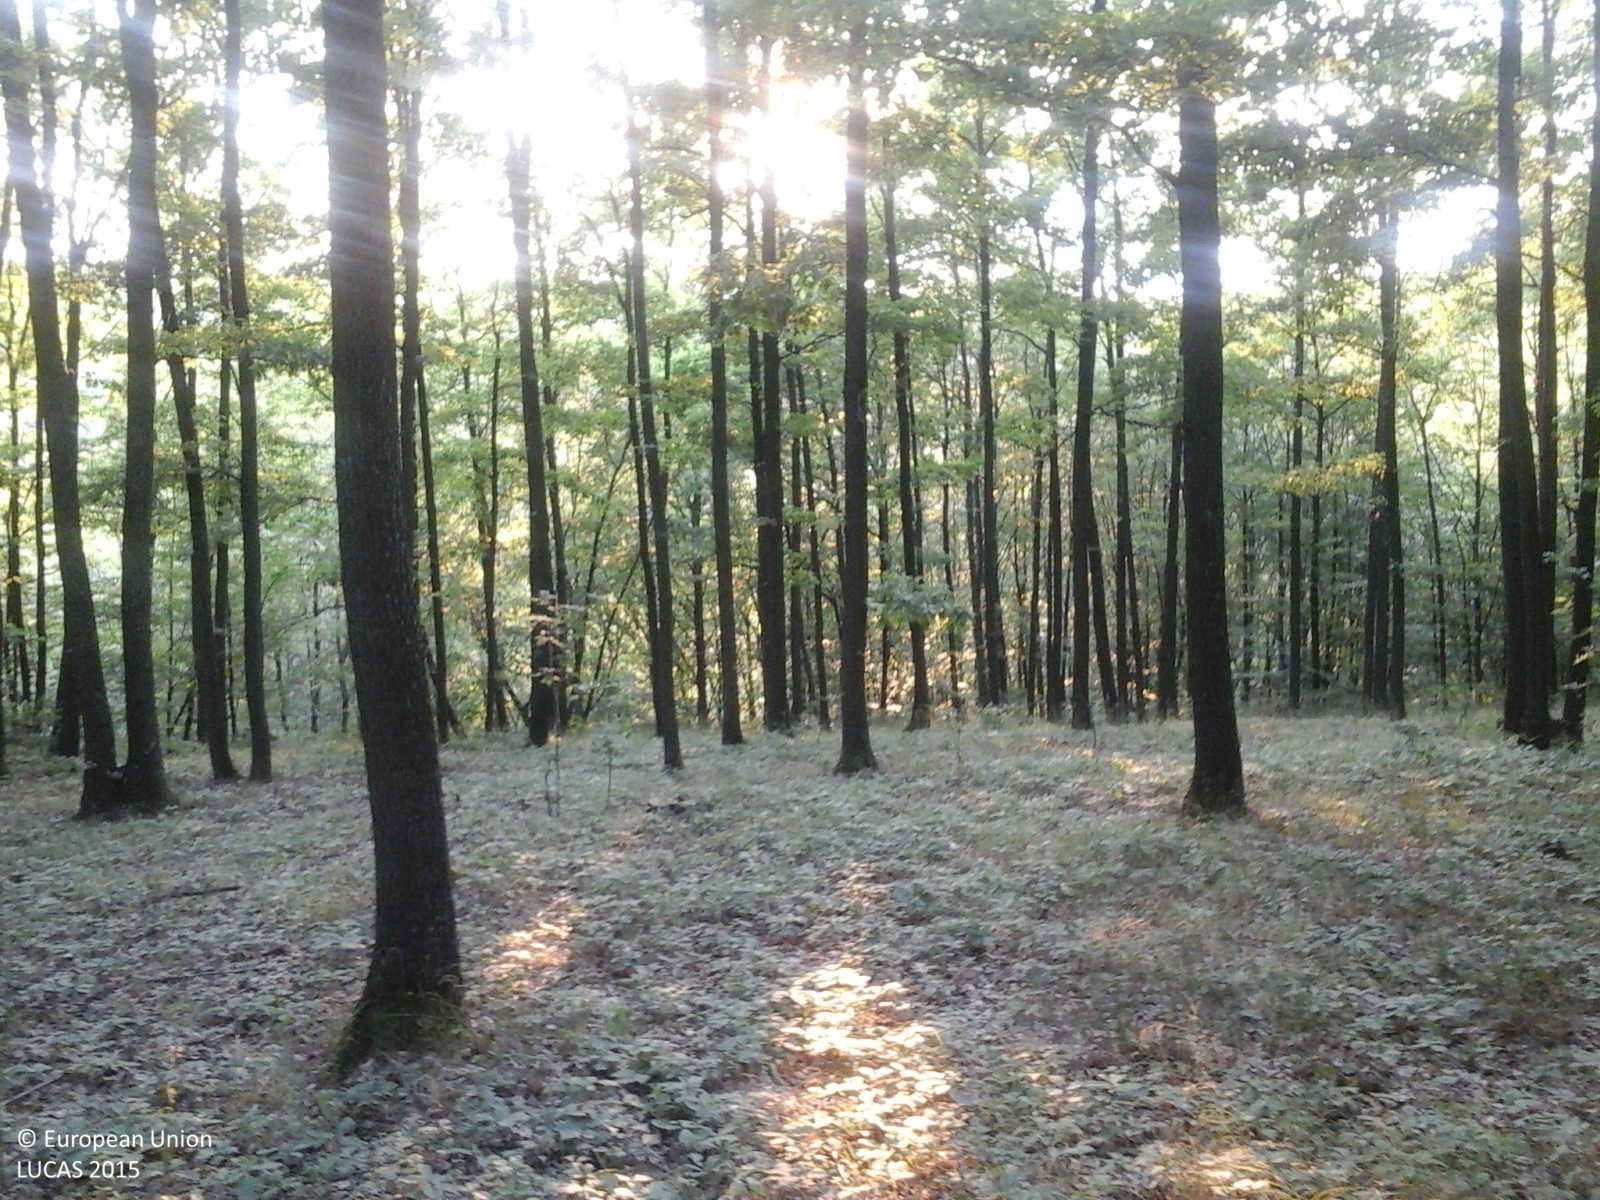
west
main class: Woodland
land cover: Broadleaved woodland
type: acidophilous oak and oak-birch forest
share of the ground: > 75 %
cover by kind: broadleaved forest trees 100 %
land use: Forestry
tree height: > 5 m
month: July
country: RO
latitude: 44.8469
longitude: 24.7428
